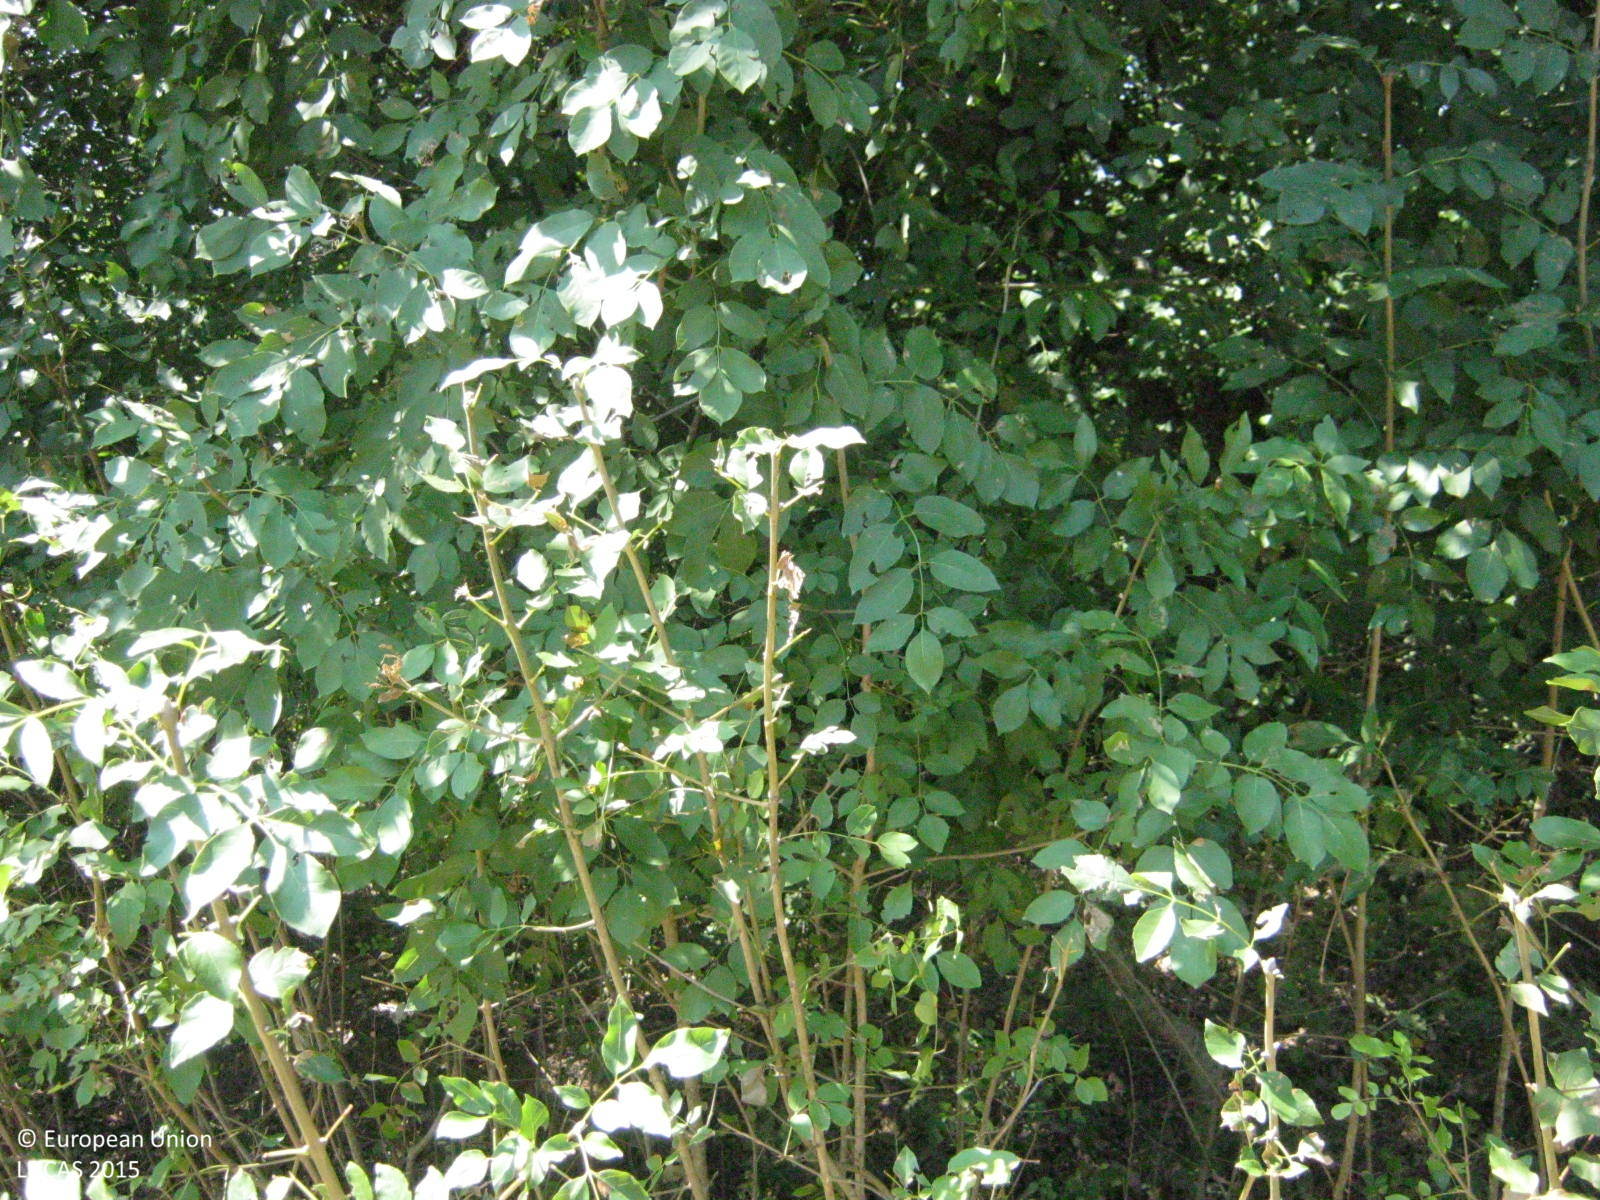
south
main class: Grassland
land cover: Spontaneously vegetated surfaces
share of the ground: > 75 %
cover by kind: herbaceous plants 100 %
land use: Fallow land
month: August
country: GR
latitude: 41.1741
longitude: 22.8499
